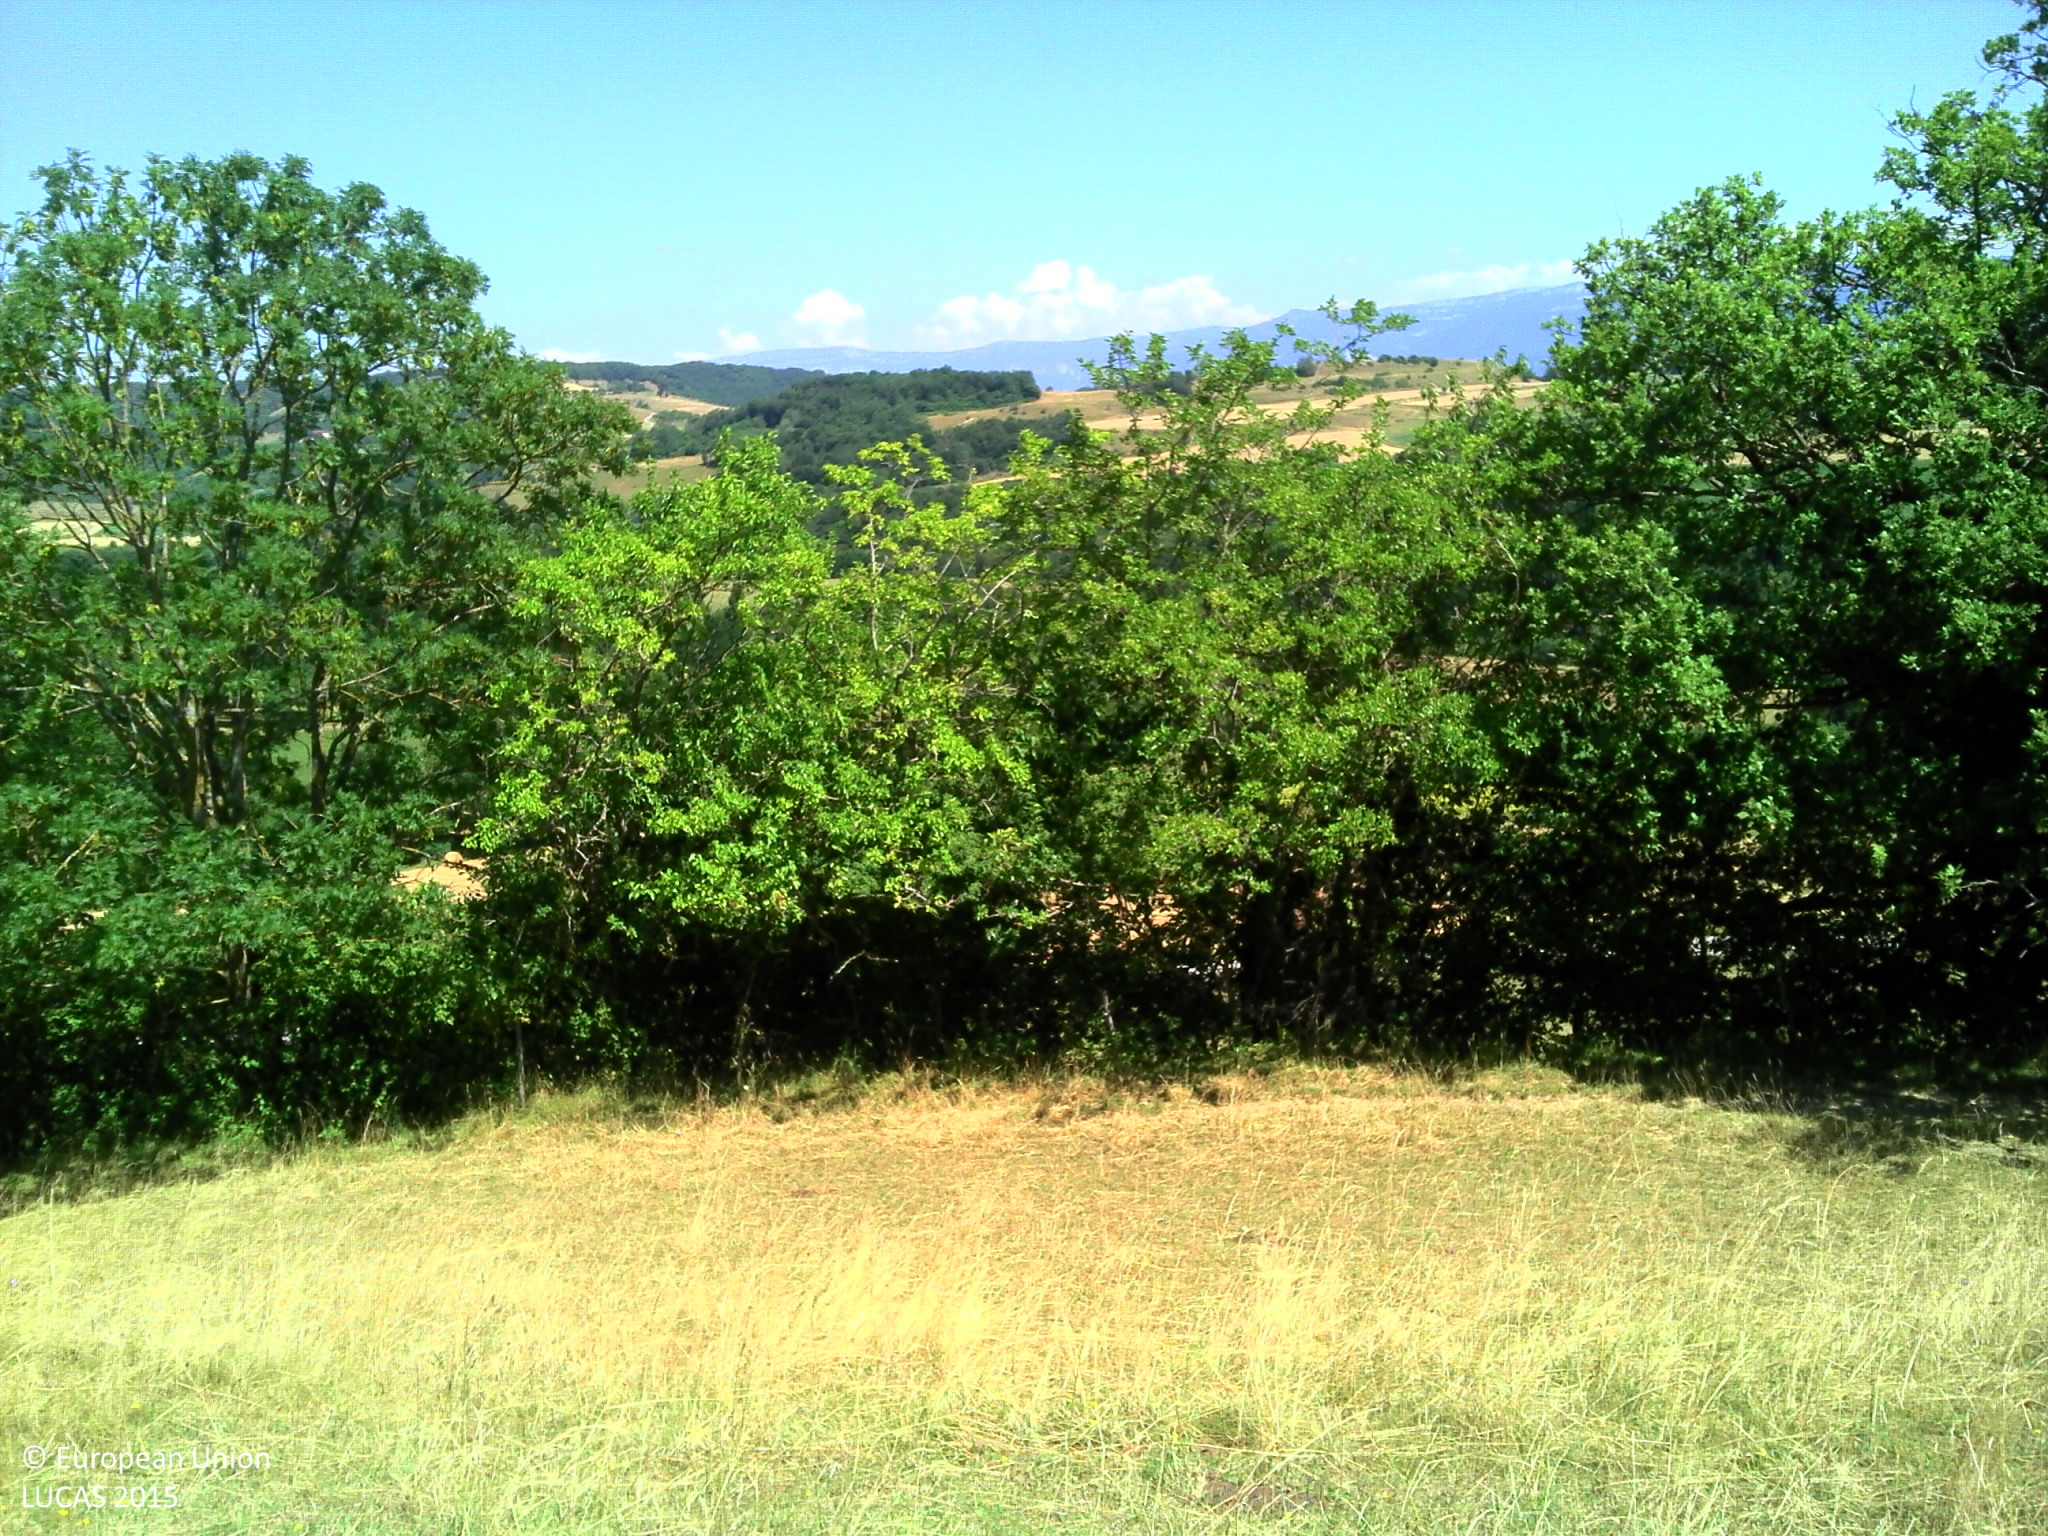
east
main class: Grassland
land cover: Grassland without tree/shrub cover
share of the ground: > 75 %
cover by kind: herbaceous plants 100 %
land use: Agriculture (excluding fallow land and kitchen gardens)
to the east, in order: Grassland without tree/shrub cover; Abandoned hedges; Grassland without tree/shrub cover; Lines of trees; Ditches and canals; Paved roads, cycling and walking lanes; Shruby margins; Durum wheat; Tracks; Sunflower
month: July
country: FR
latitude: 45.1970
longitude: 5.2062
